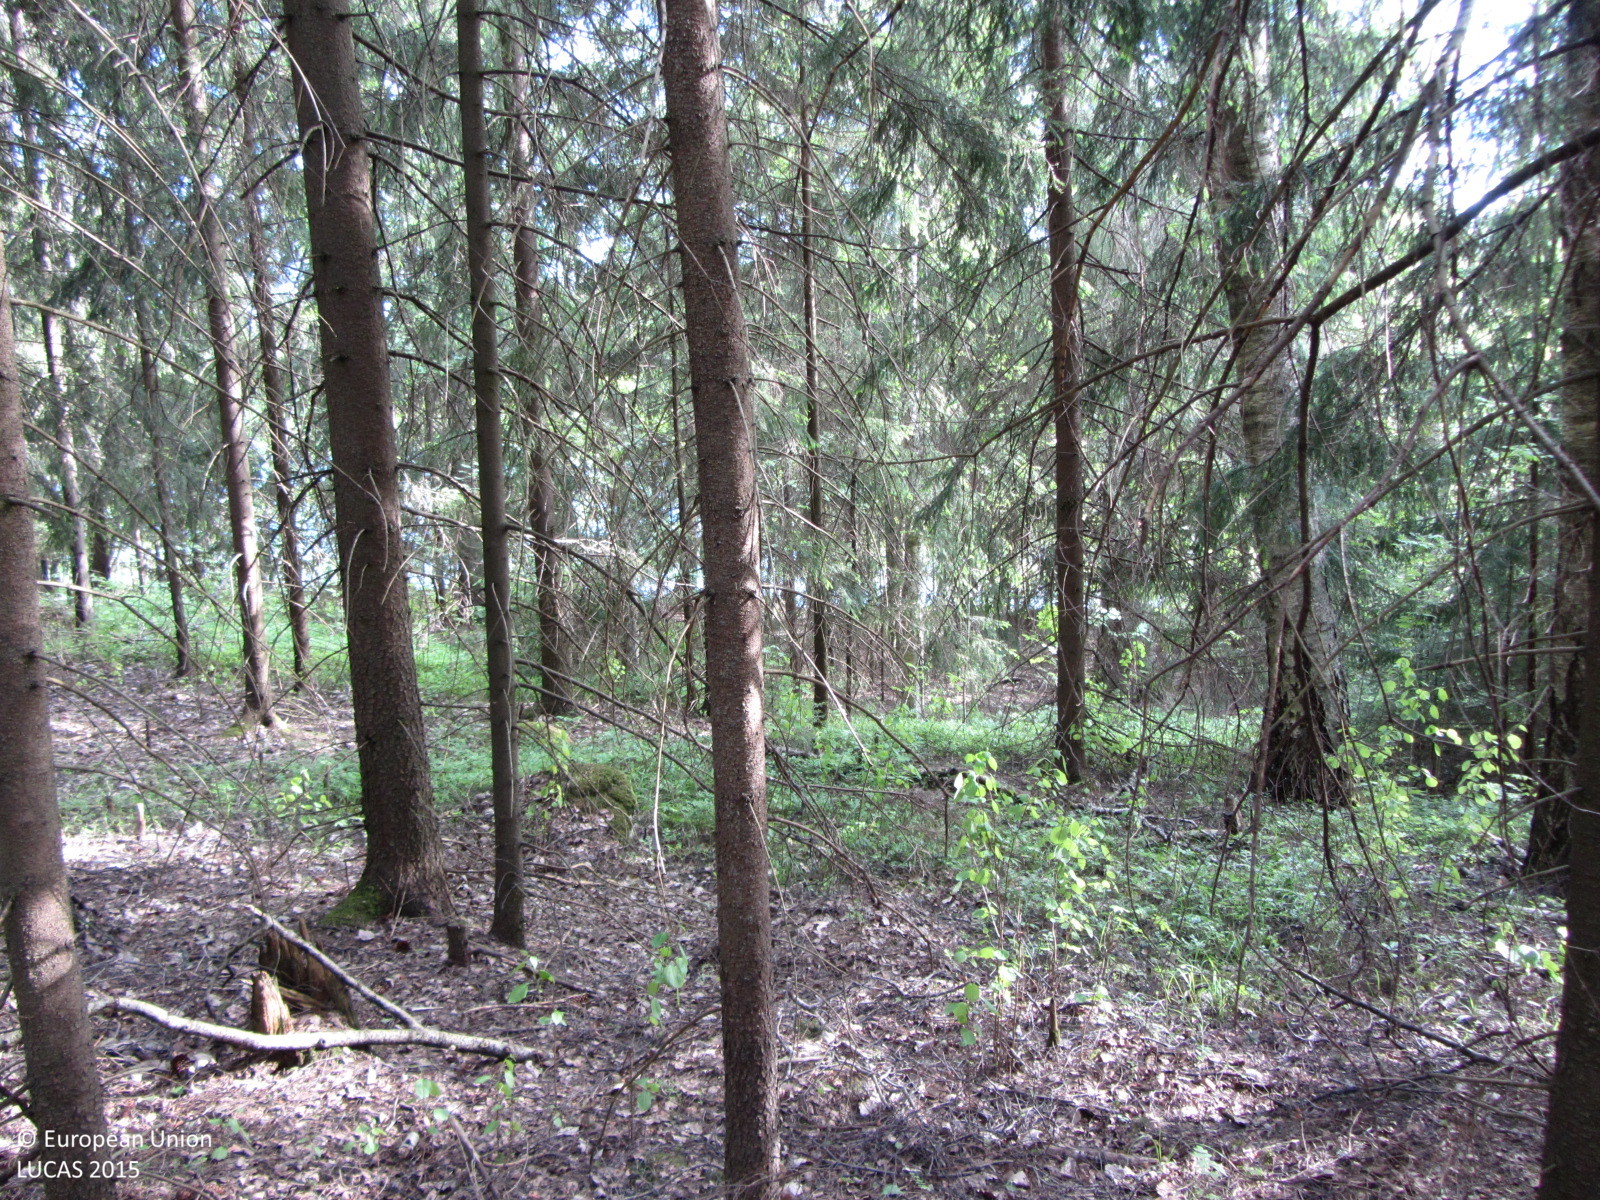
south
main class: Woodland
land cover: Spruce dominated mixed woodland
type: boreal forest
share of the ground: 50 - 75 %
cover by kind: coniferous forest trees 40 %, broadleaved forest trees 20 %, herbaceous plants 20 %, unconsolidated bare surface 20 %
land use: Residential
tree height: > 5 m
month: June
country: FI
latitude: 60.3149
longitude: 24.2402
